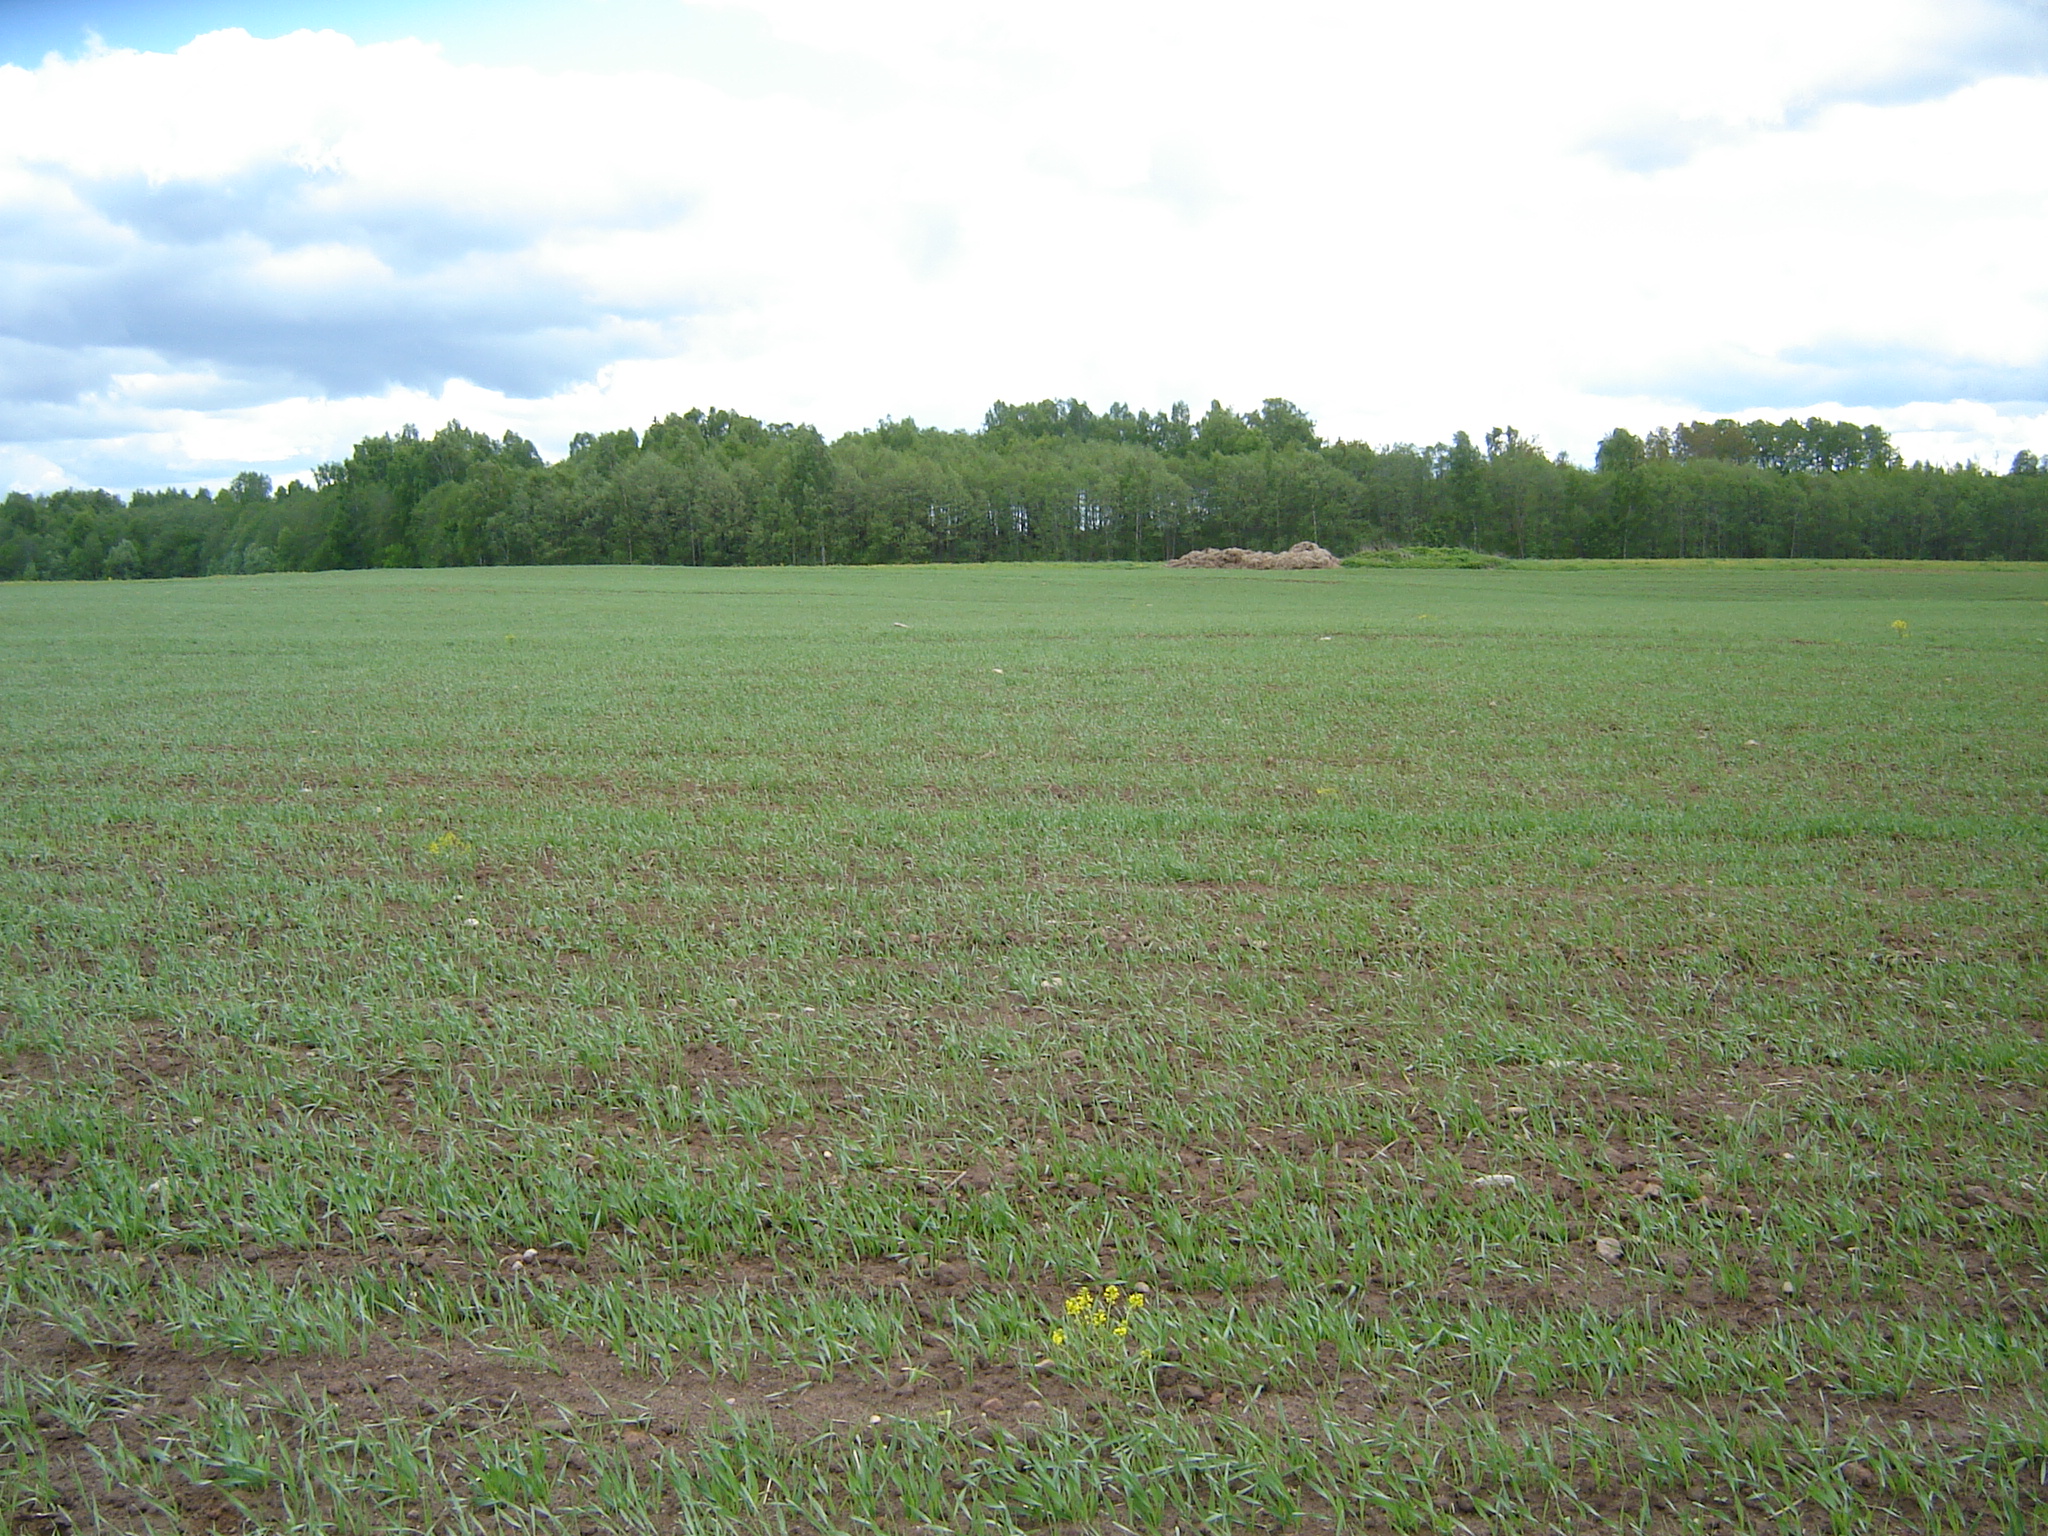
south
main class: Cropland
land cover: Barley
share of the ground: 25 - 50 %
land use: Agriculture (excluding fallow land and kitchen gardens)
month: May
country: LT
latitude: 56.0171
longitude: 25.2761
